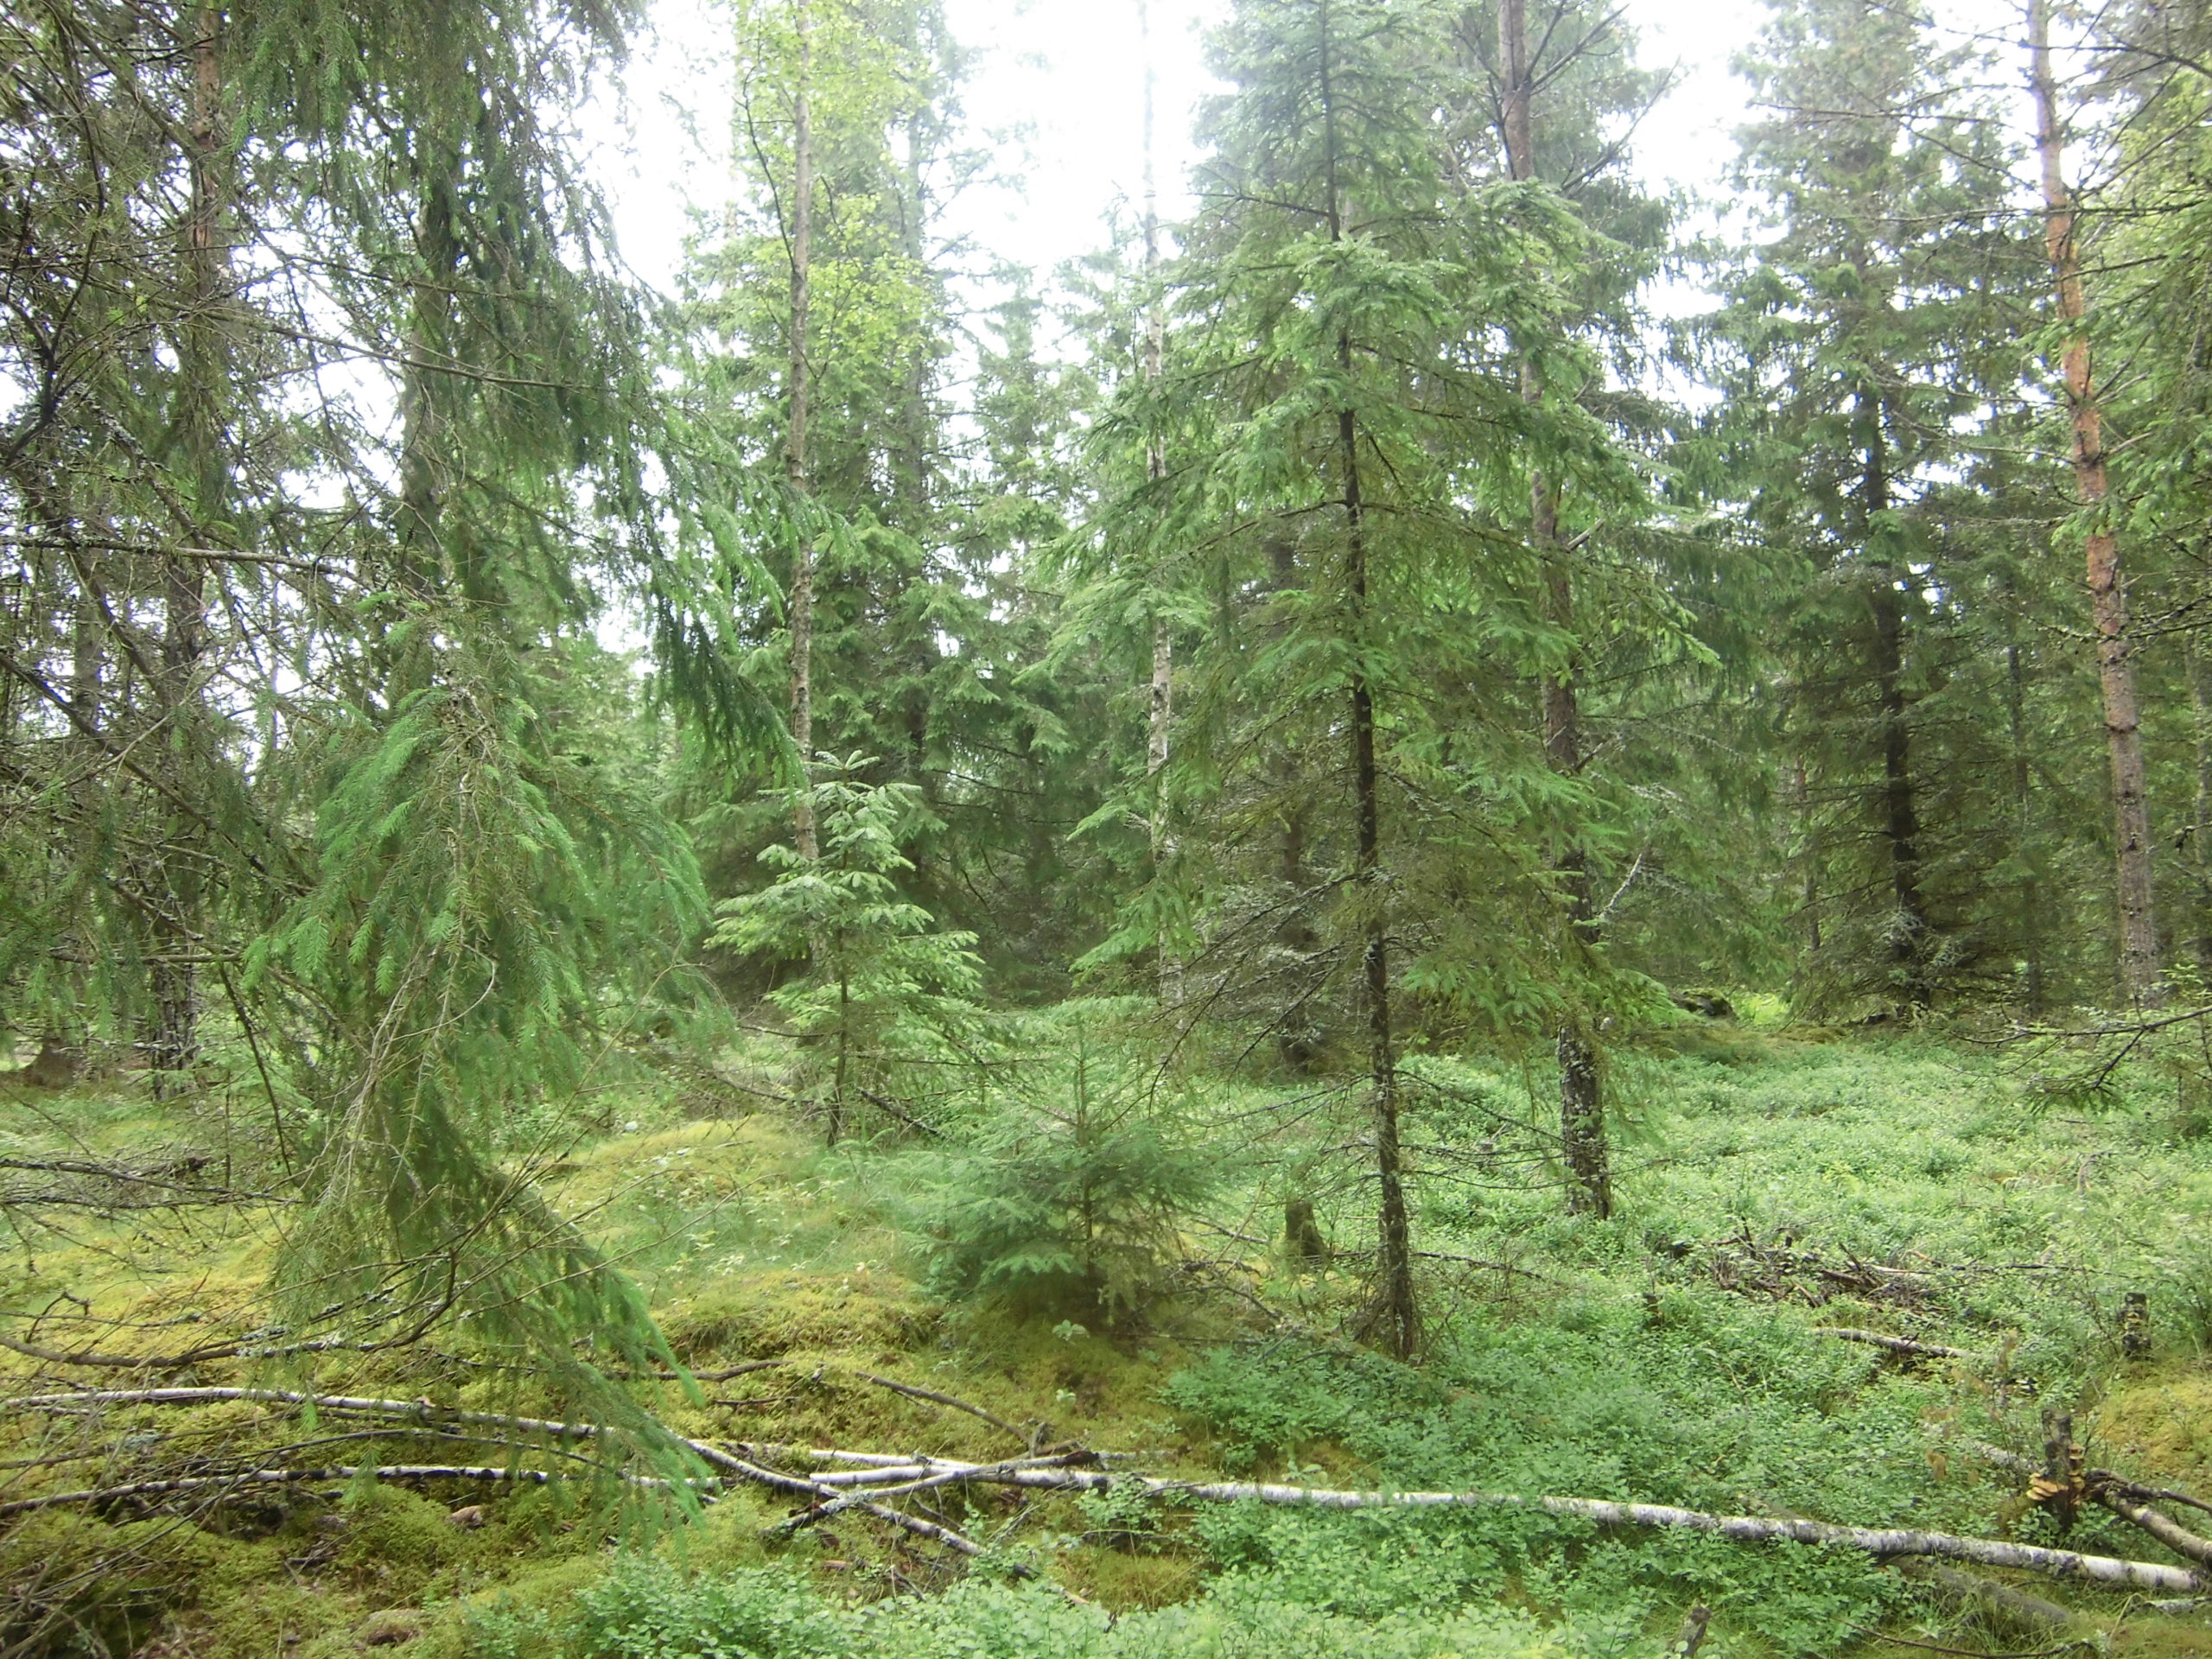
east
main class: Woodland
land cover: Spruce dominated coniferous woodland
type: boreal forest
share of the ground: 50 - 75 %
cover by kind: coniferous forest trees 55 %, lichens and mosses 20 %, herbaceous plants 15 %, broadleaved forest trees 5 %, shrubs 5 %
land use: Forestry
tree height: > 5 m
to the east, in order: Spruce dominated coniferous woodland; Ditches and canals; Spruce dominated coniferous woodland
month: July
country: SE
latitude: 57.1402
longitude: 15.3349
